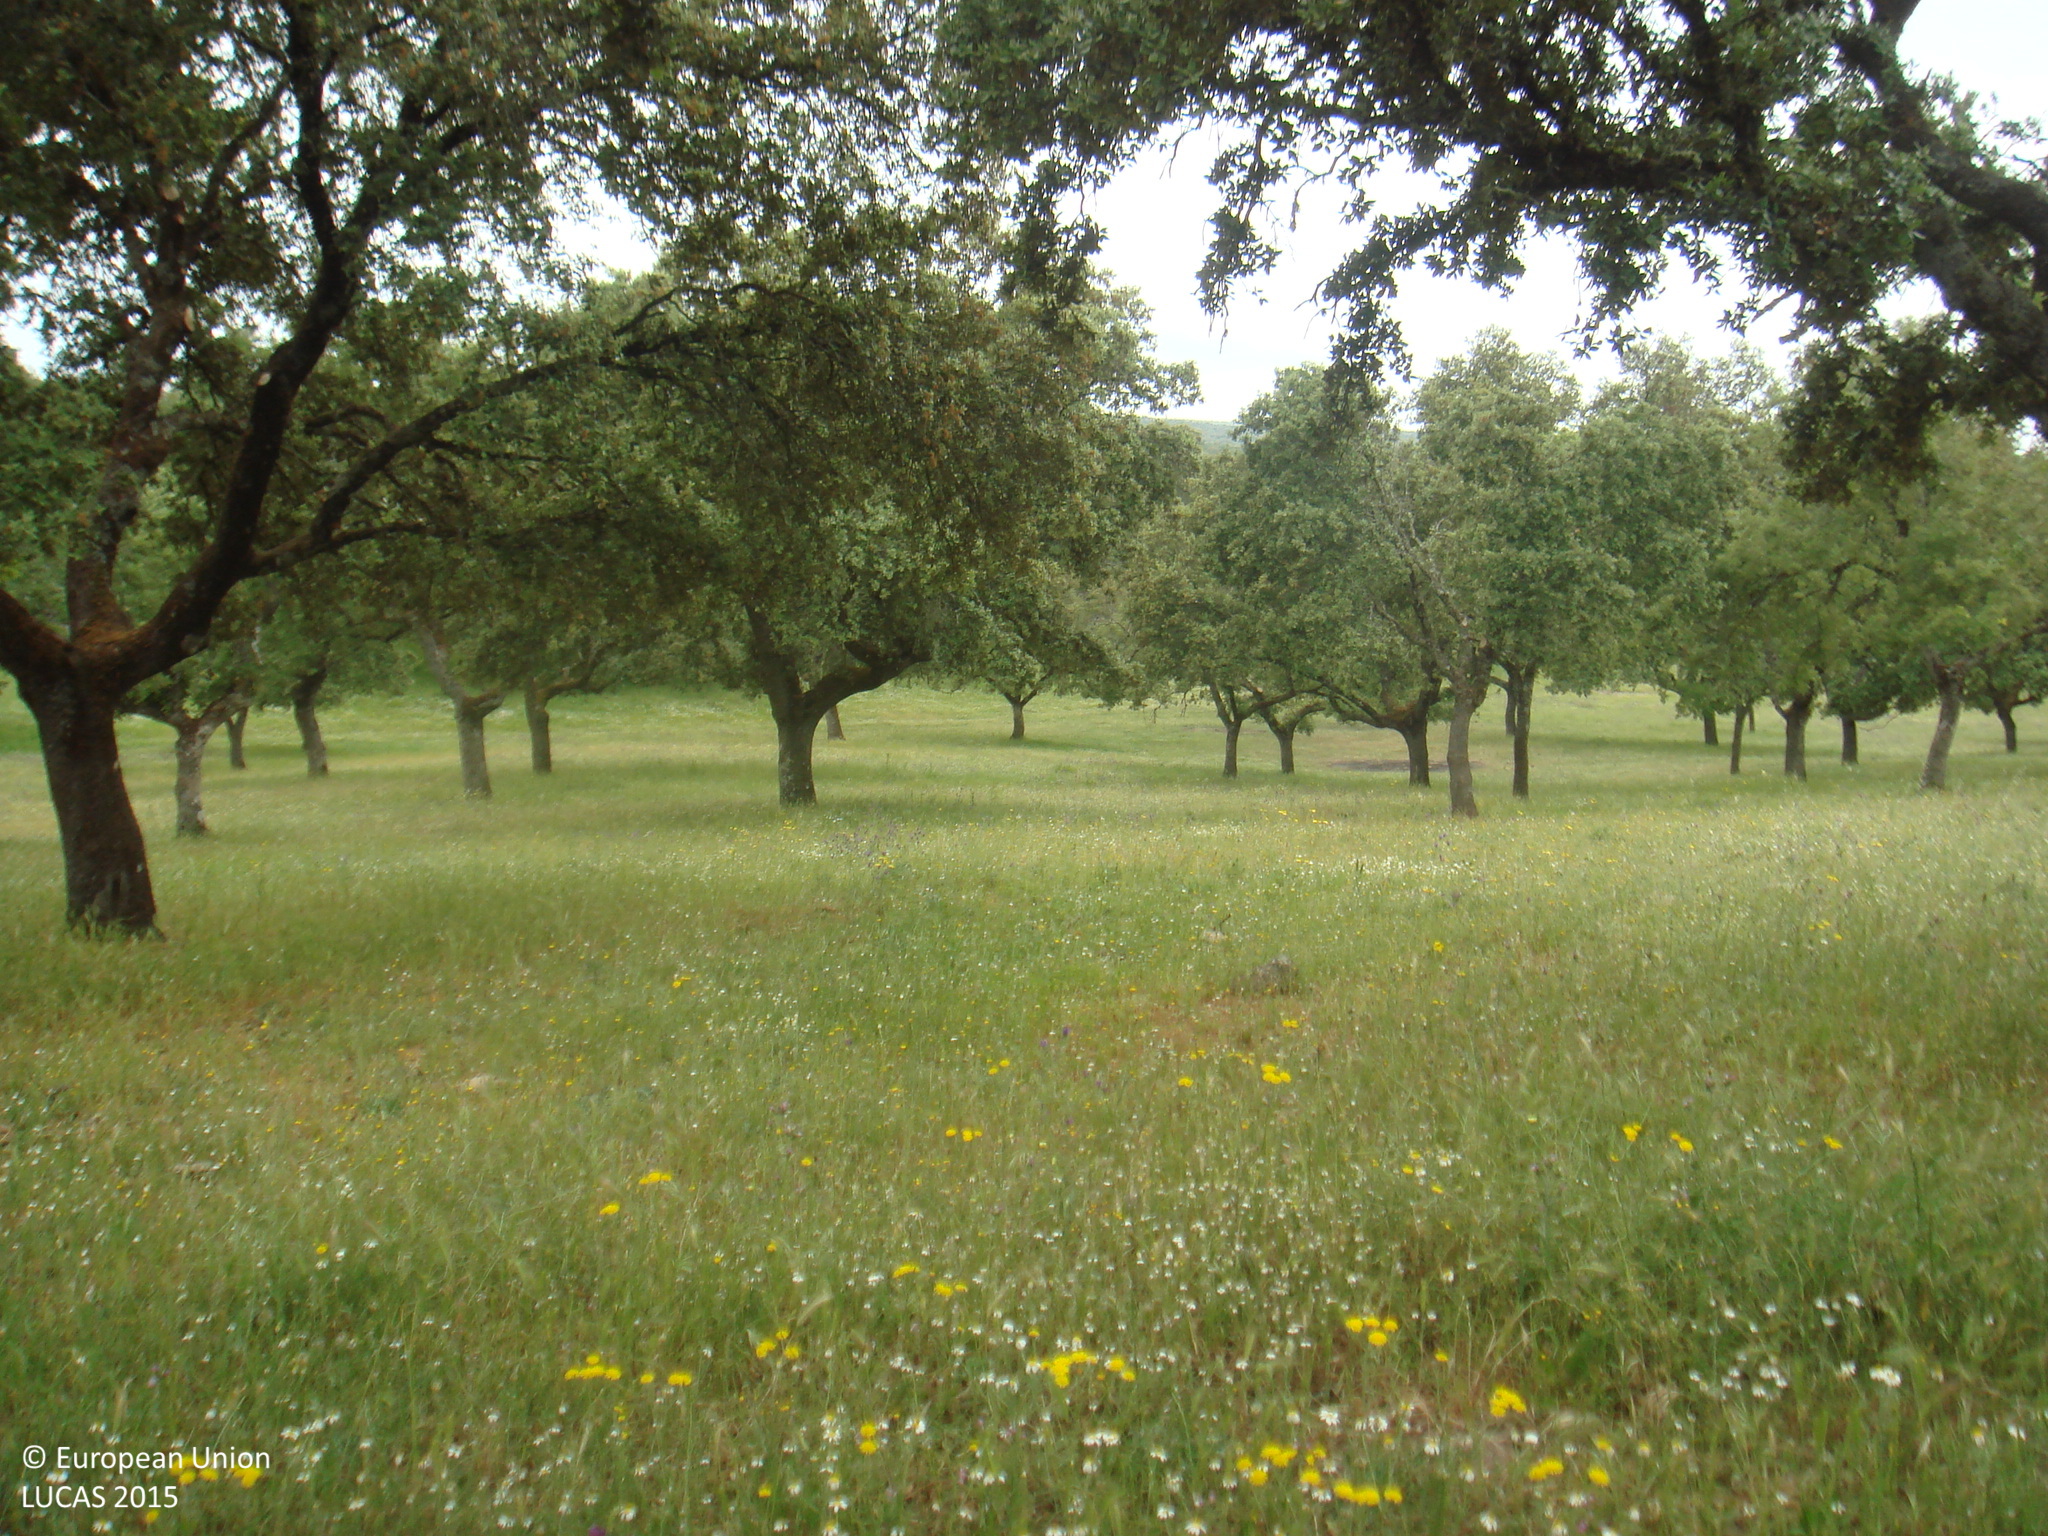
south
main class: Woodland
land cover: Broadleaved woodland
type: broadleaved evergreen forest
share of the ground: 25 - 50 %
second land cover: Grassland without tree/shrub cover
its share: 50 - 75 %
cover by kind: herbaceous plants 60 %, broadleaved forest trees 40 %
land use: Forestry
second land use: Agriculture (excluding fallow land and kitchen gardens)
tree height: > 5 m
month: May
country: ES
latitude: 38.2442
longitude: -4.4006
